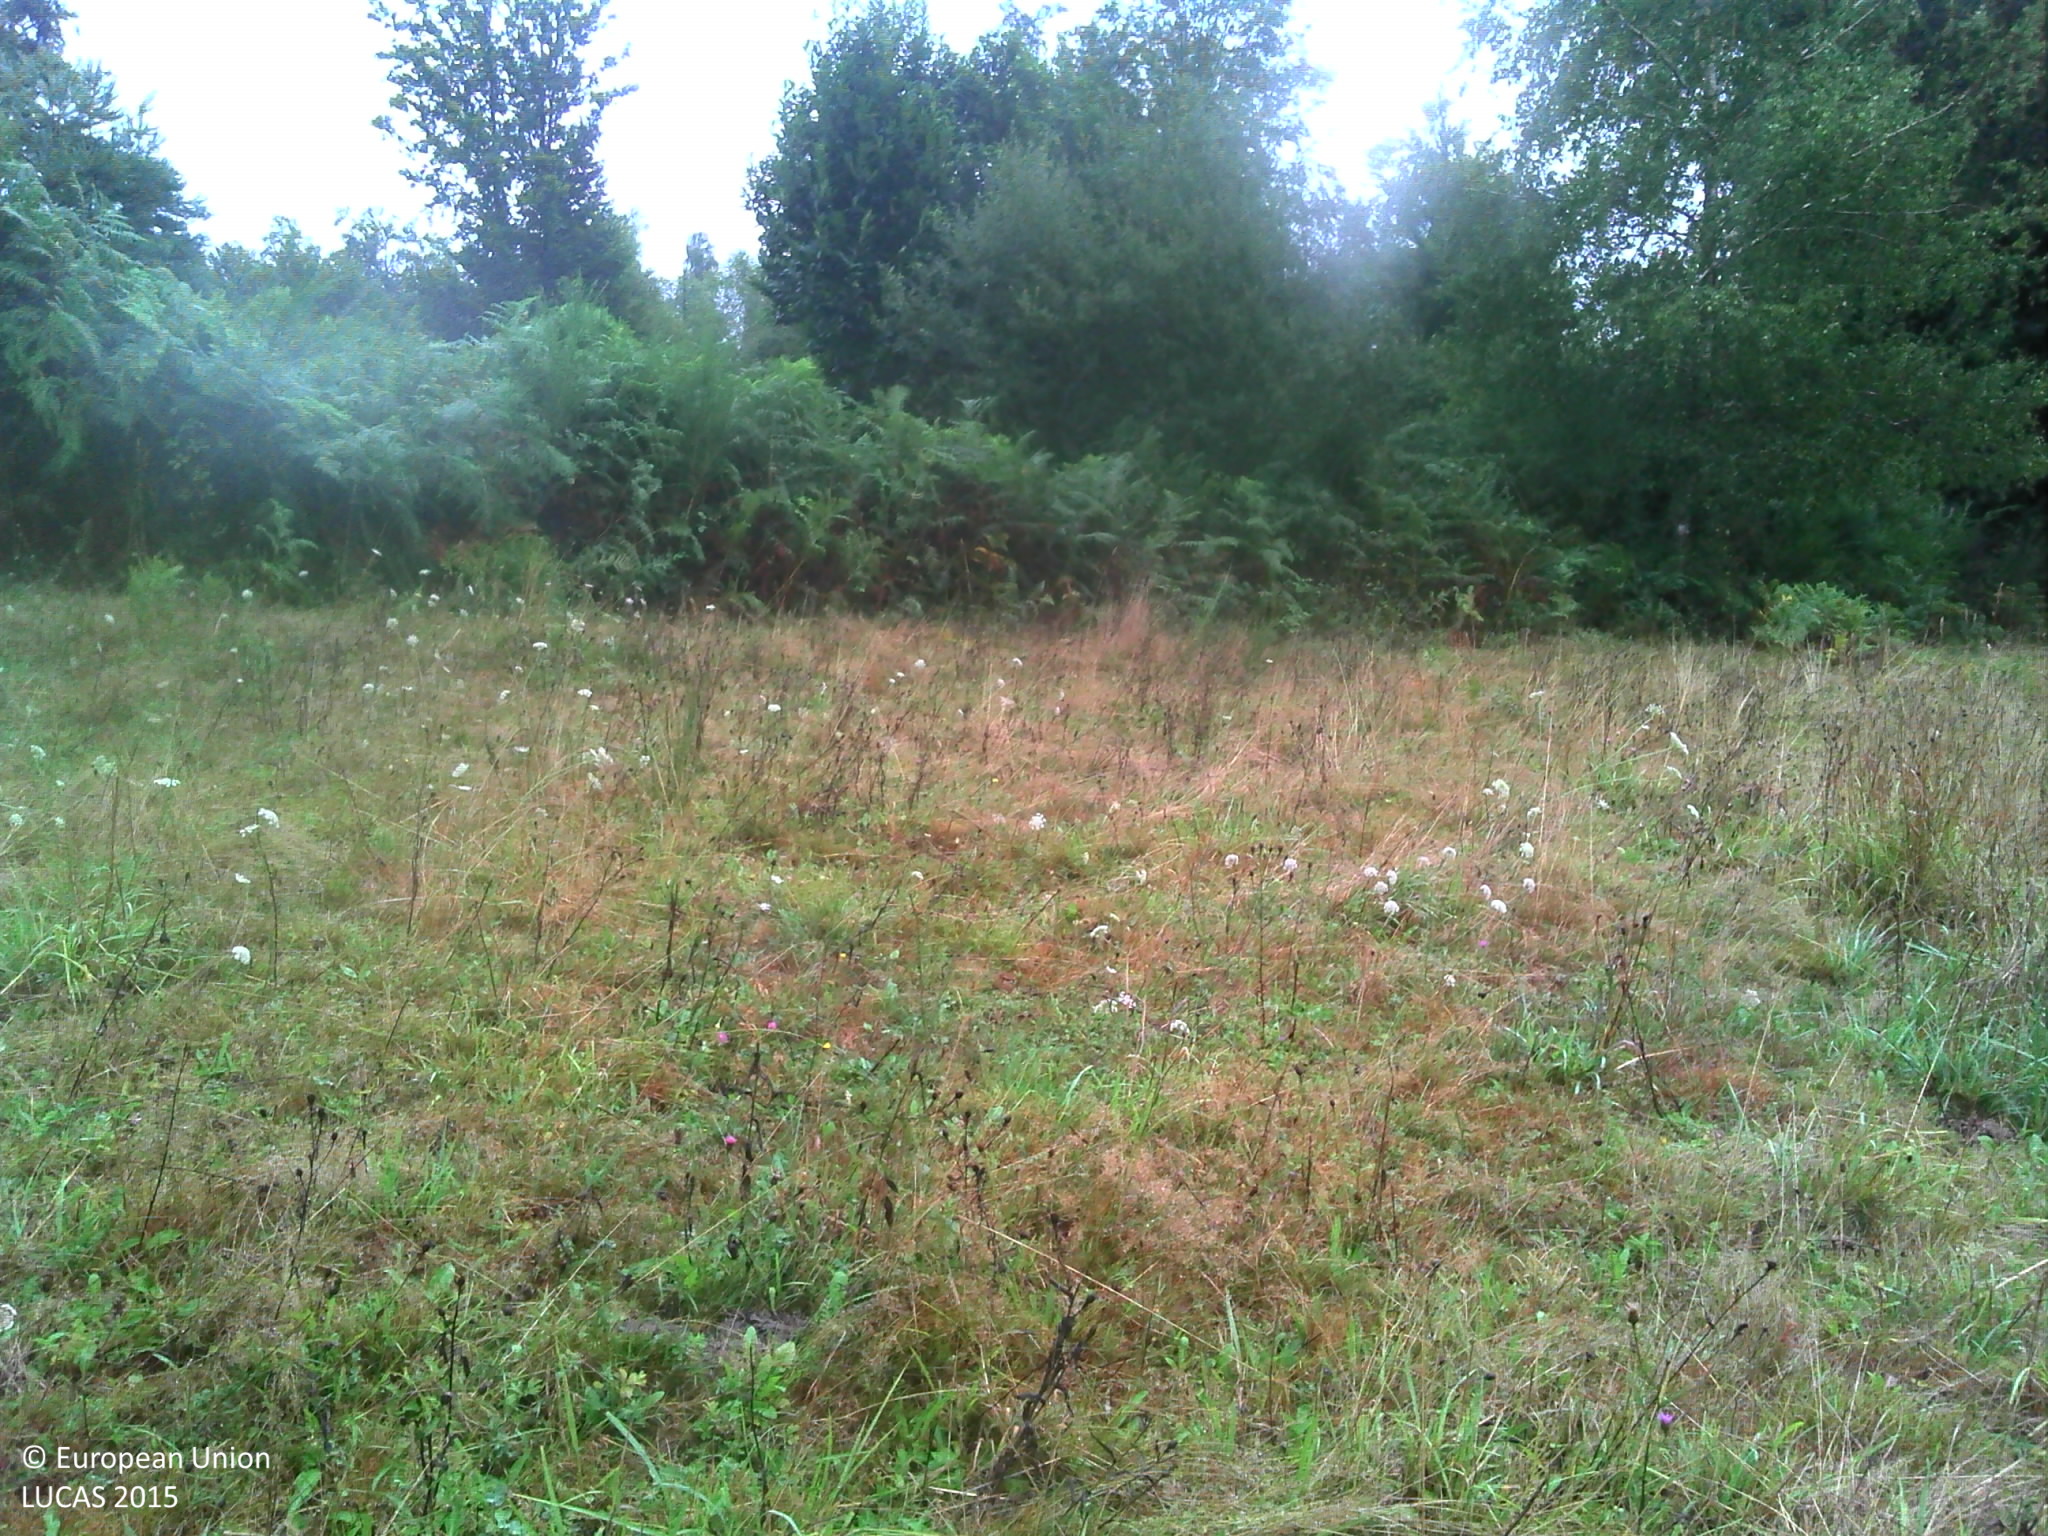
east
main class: Grassland
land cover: Grassland without tree/shrub cover
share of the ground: > 75 %
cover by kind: herbaceous plants 100 %
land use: Agriculture (excluding fallow land and kitchen gardens)
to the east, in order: Grassland without tree/shrub cover; Fences; Artificial constructions in urban areas; Lines of trees; Broadleaved woodland; Fences; Grassland without tree/shrub cover
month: August
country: FR
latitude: 45.9563
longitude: 1.2554
